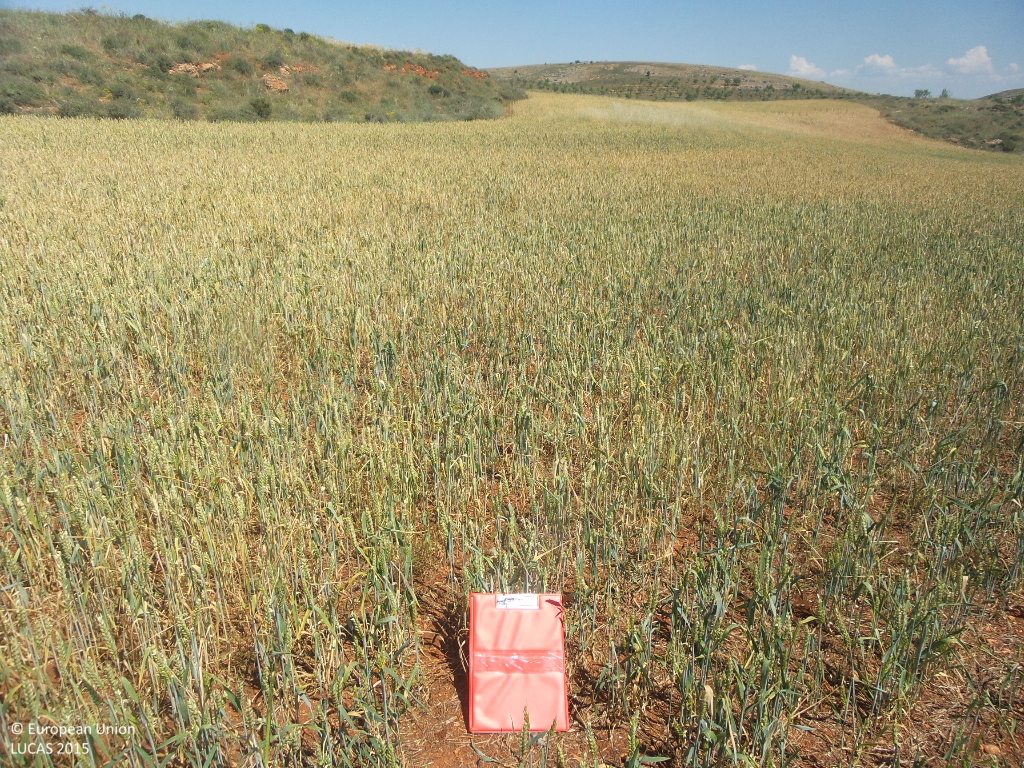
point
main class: Cropland
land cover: Common wheat
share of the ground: > 75 %
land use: Agriculture (excluding fallow land and kitchen gardens)
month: June
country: ES
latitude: 41.4014
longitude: -3.0671
